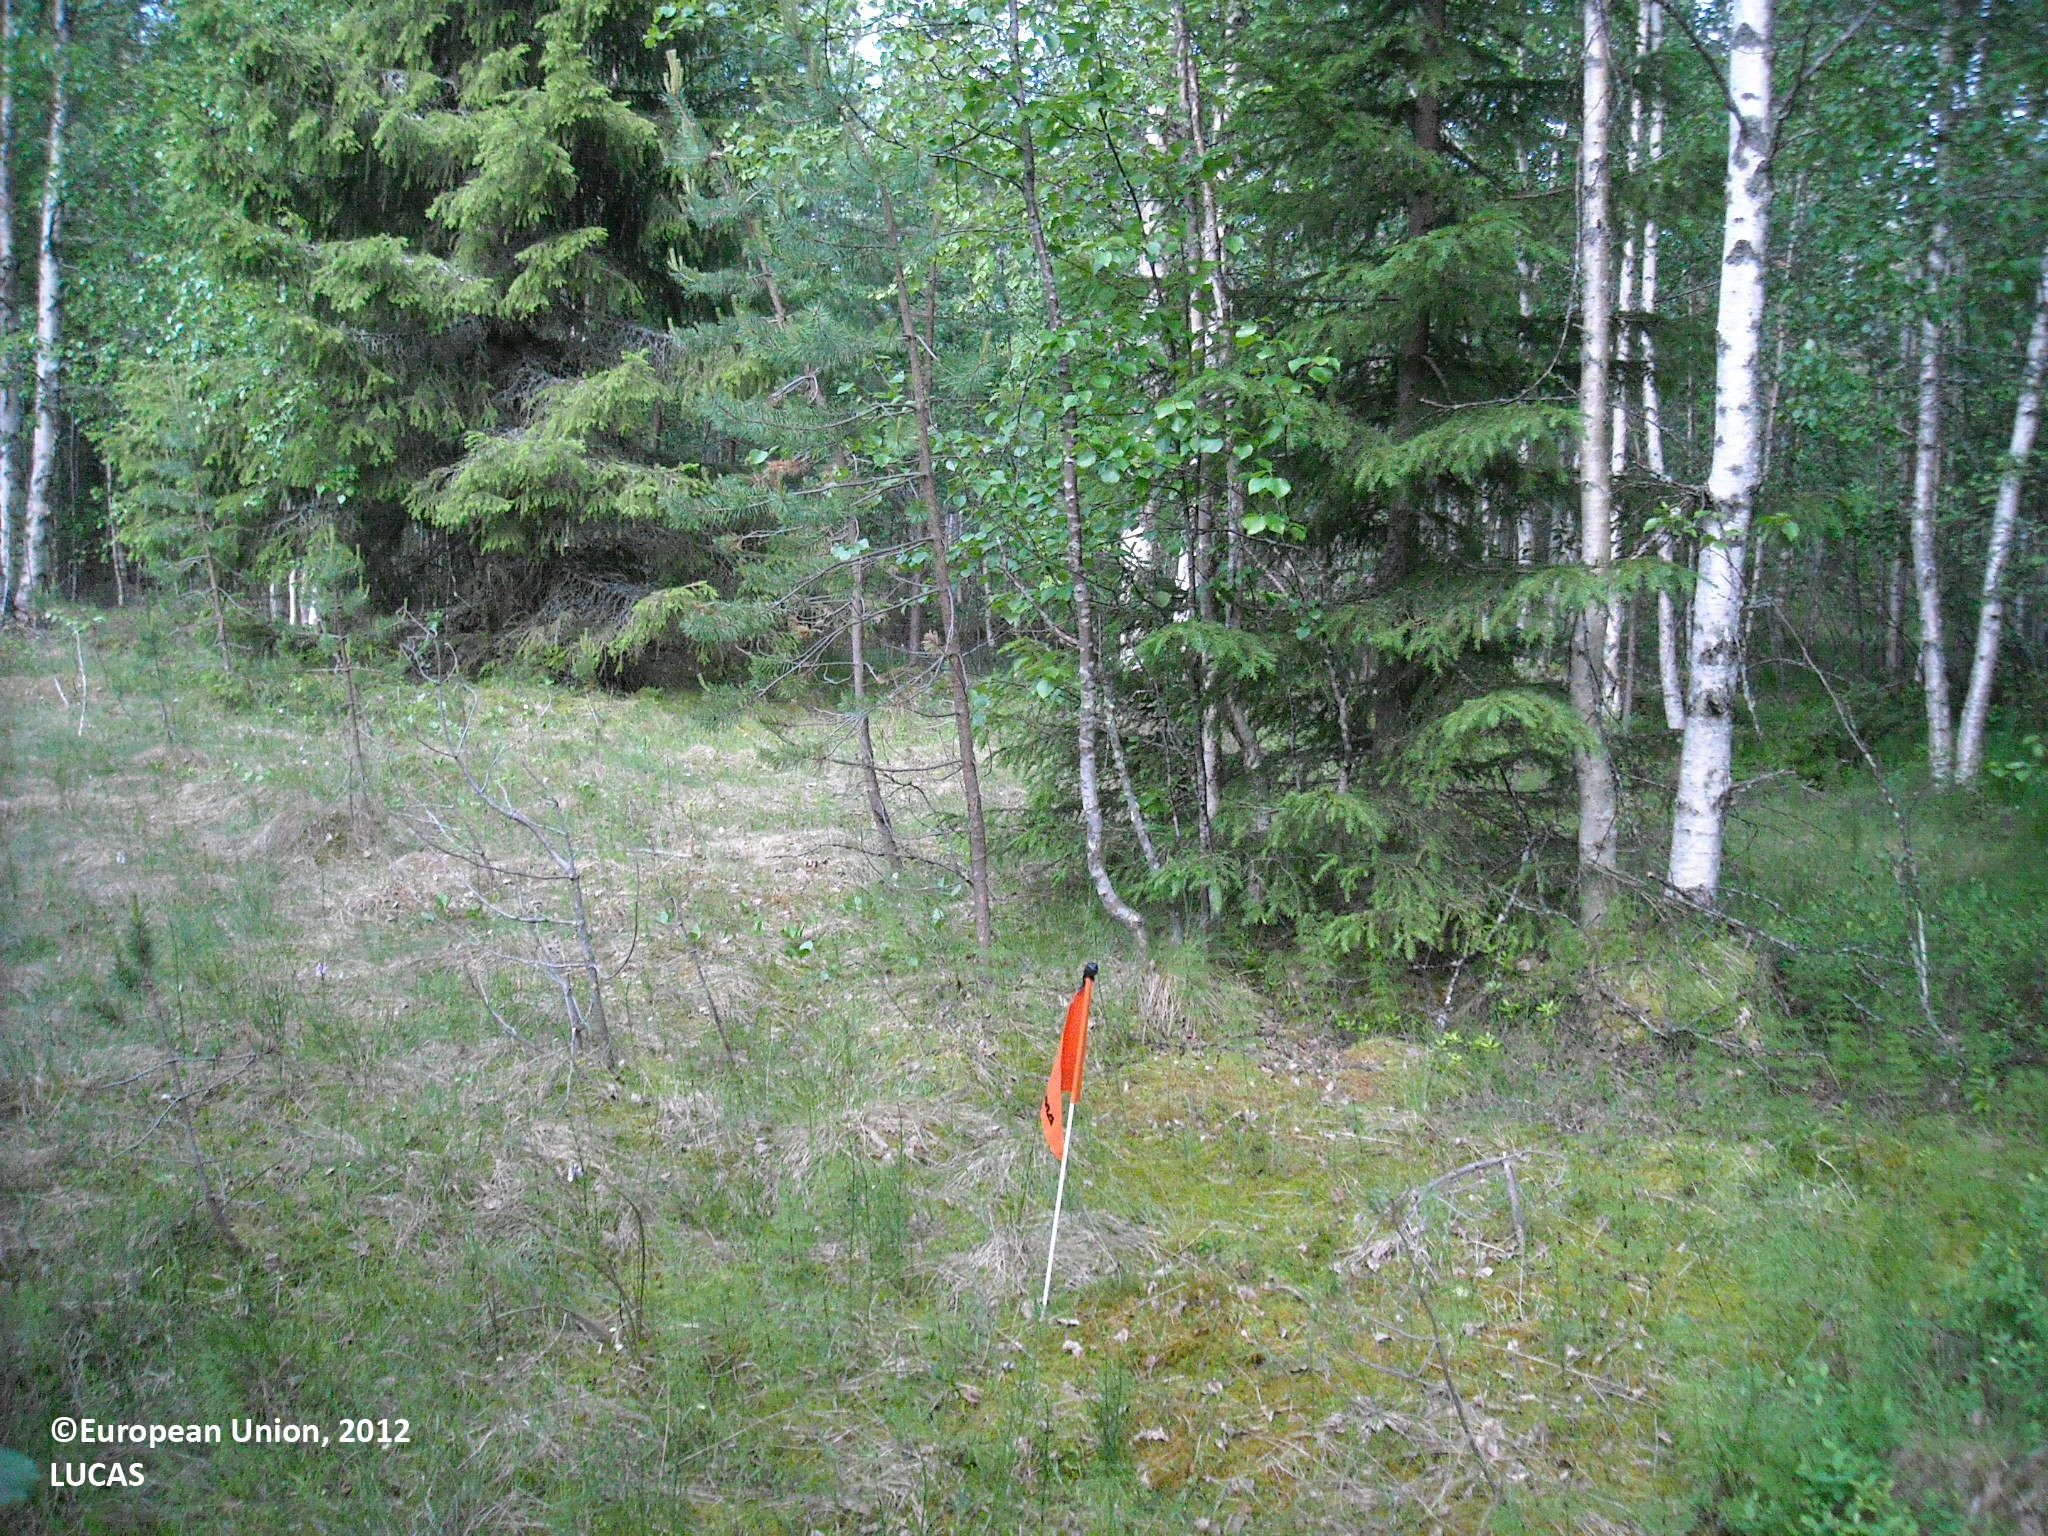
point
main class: Woodland
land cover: Other mixed woodland
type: mire and swamp forests
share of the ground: 50 - 75 %
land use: Forestry
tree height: > 5 m
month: July
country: FI
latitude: 64.6769
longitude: 27.6850
